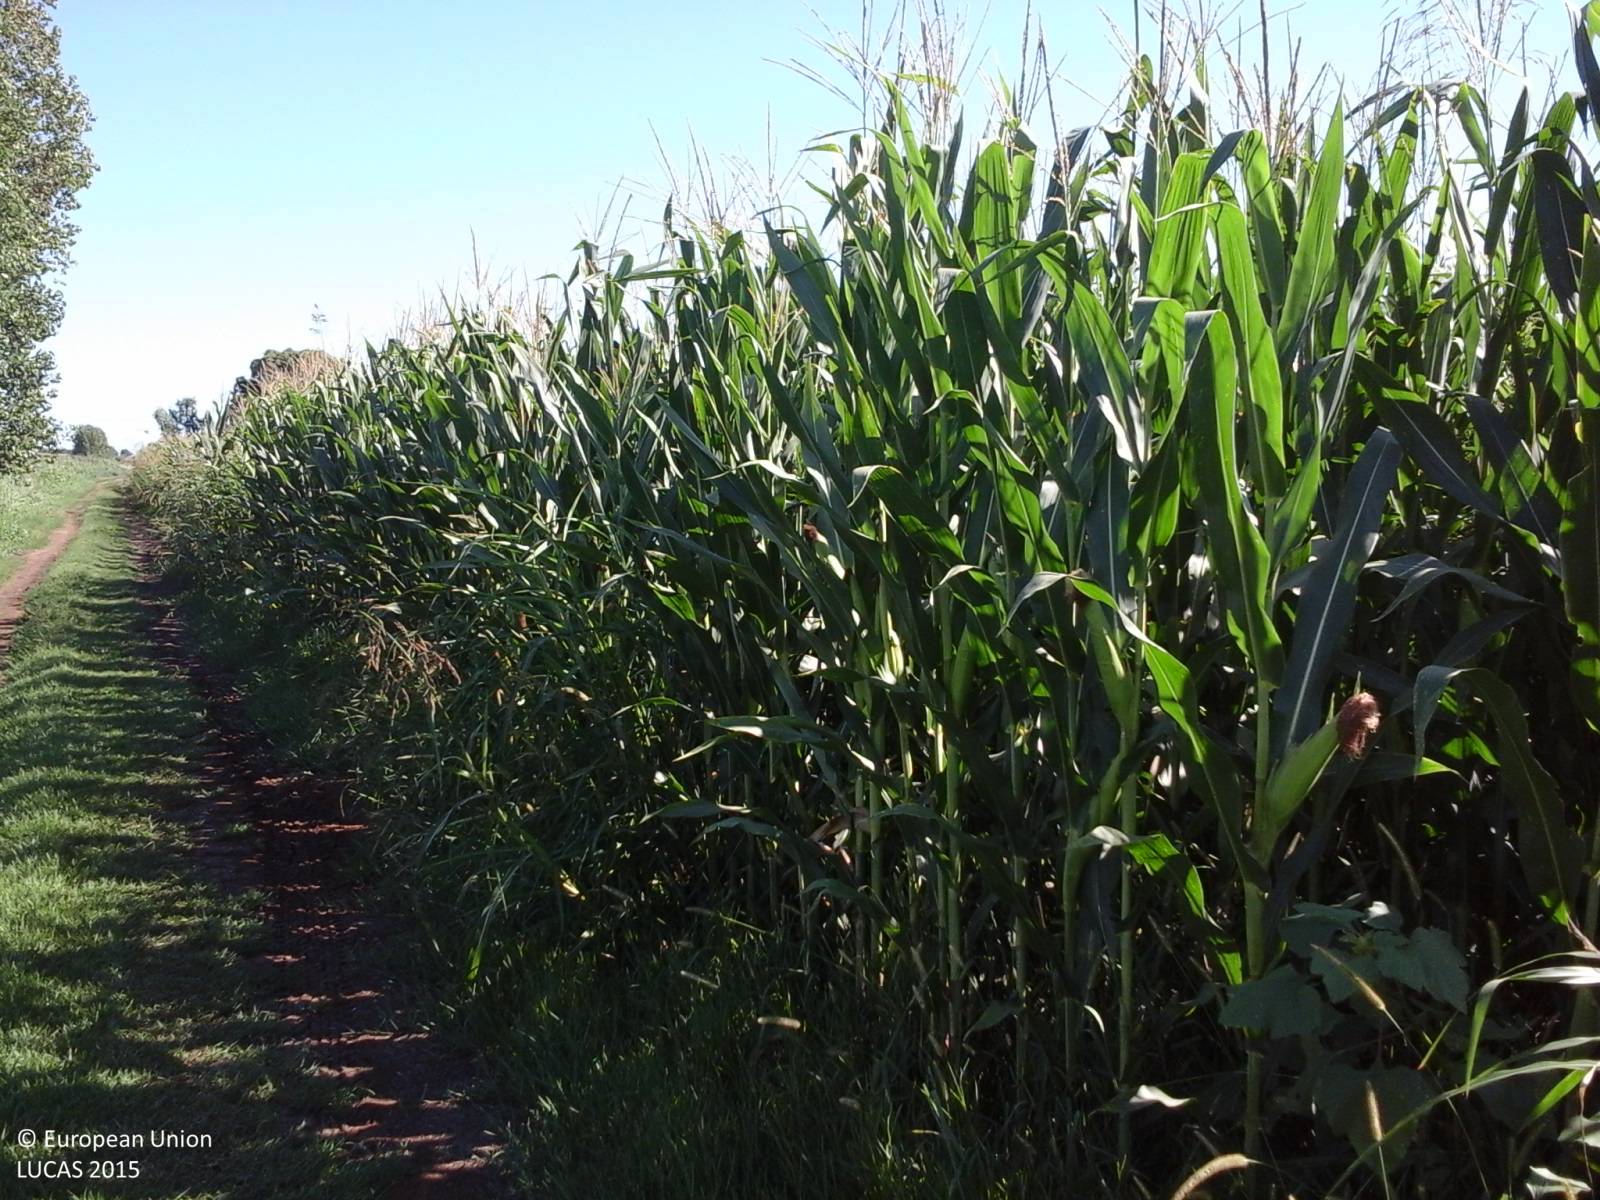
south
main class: Cropland
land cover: Maize
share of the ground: > 75 %
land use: Agriculture (excluding fallow land and kitchen gardens)
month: August
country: IT
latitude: 41.3391
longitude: 13.1540
